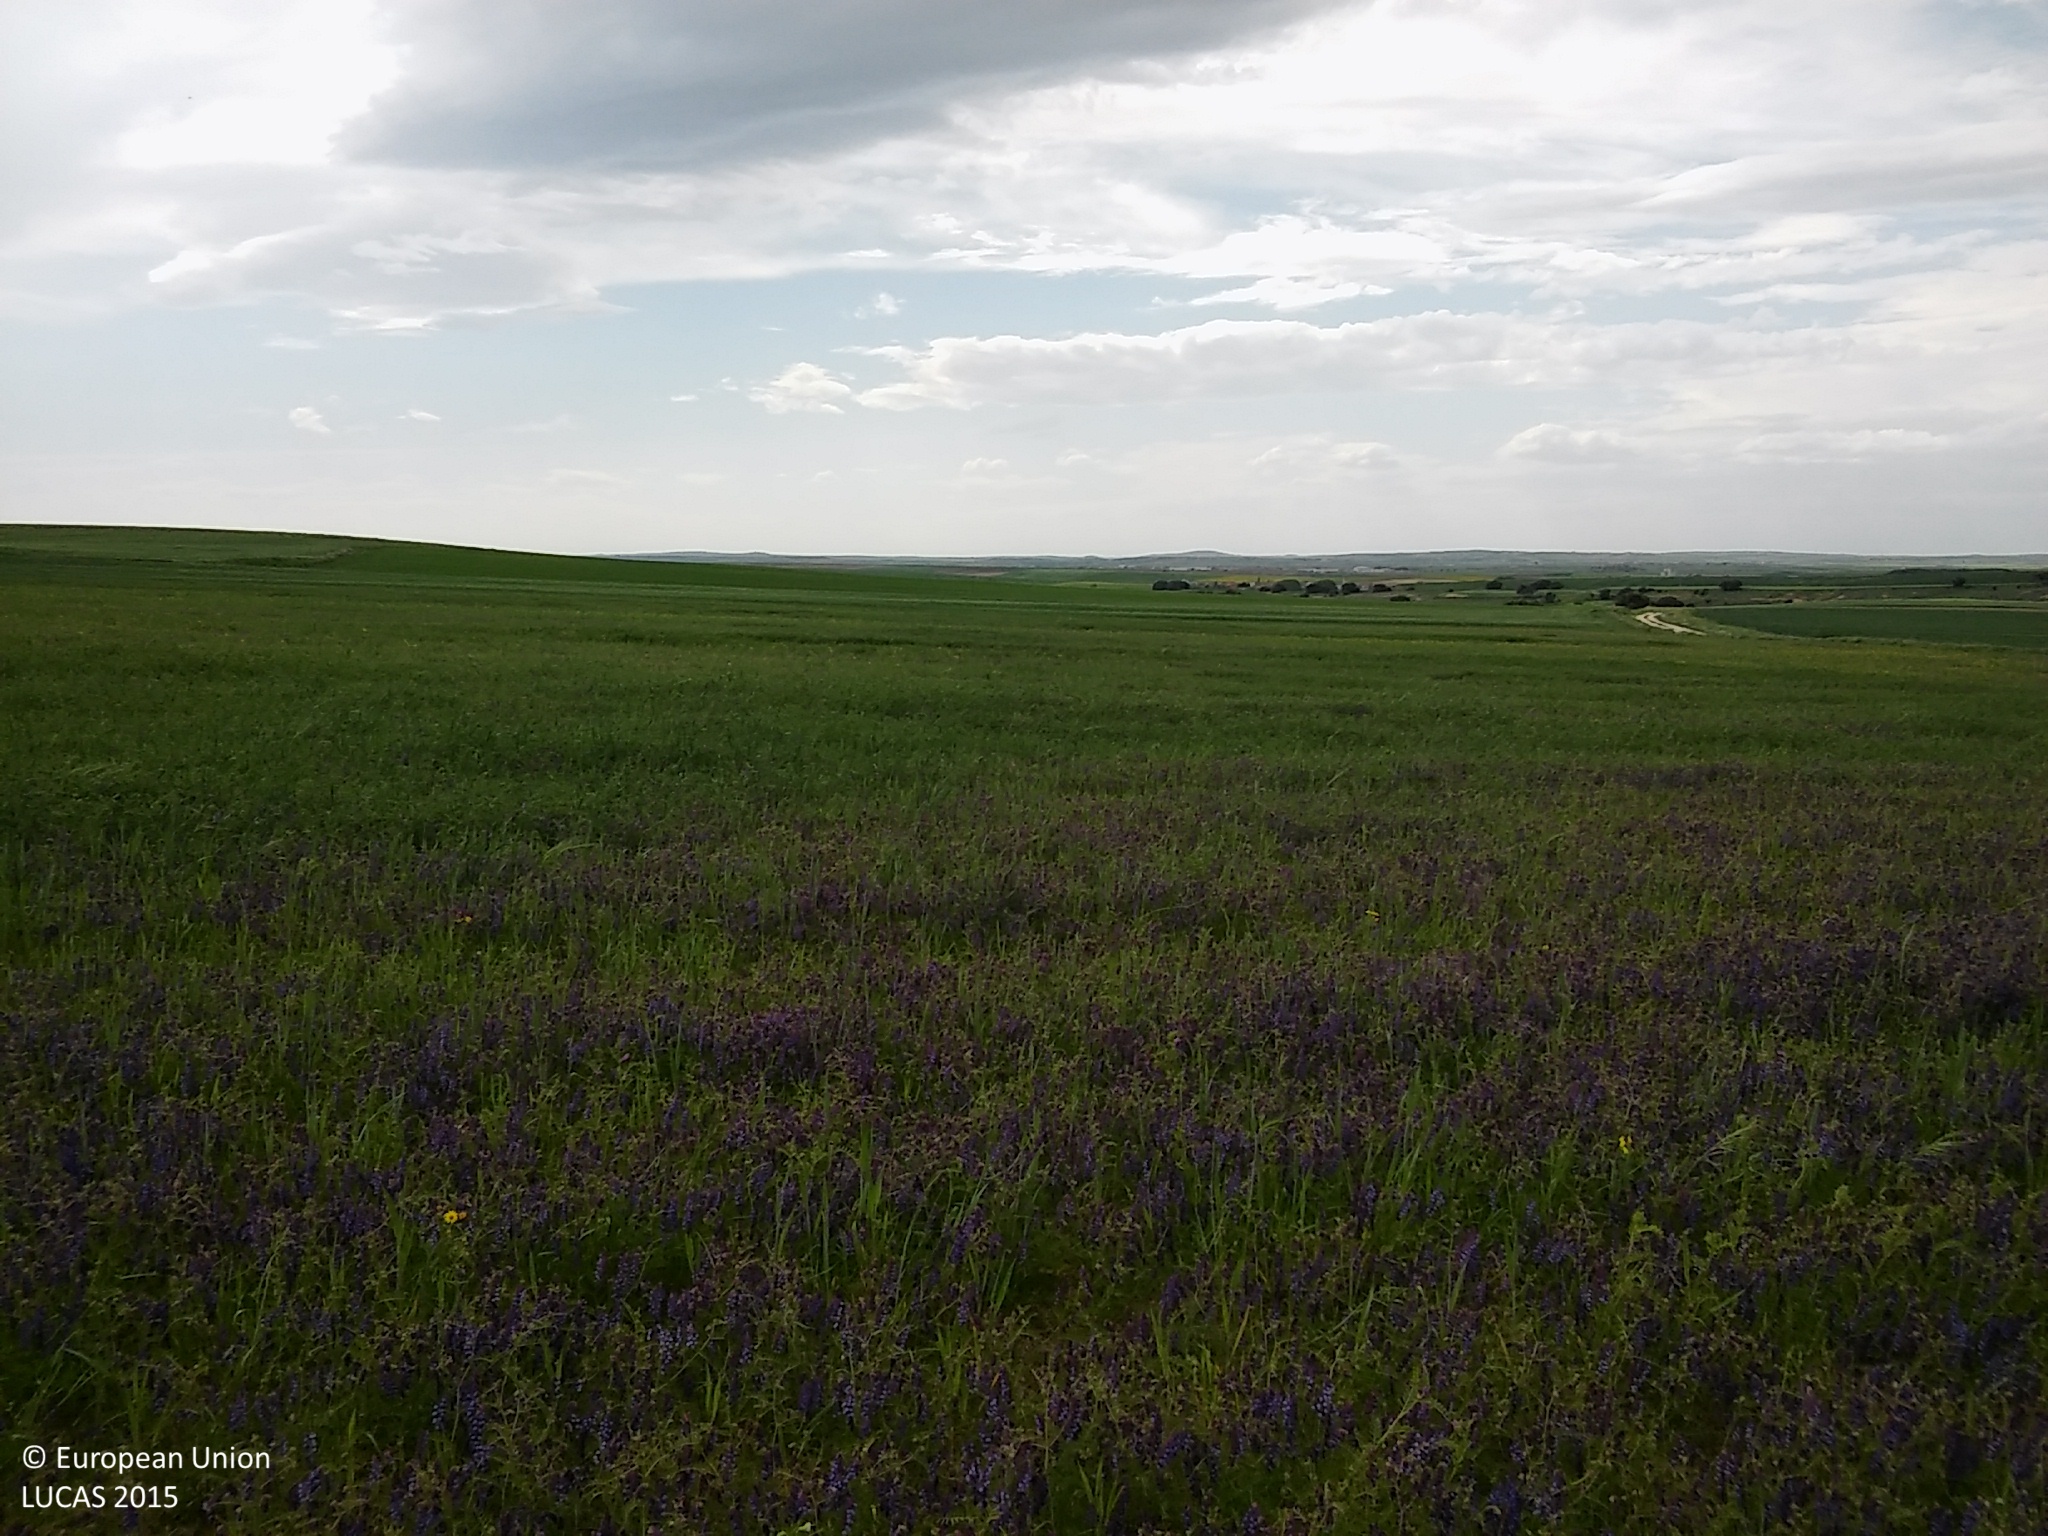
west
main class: Cropland
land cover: Dry pulses
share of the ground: > 75 %
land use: Agriculture (excluding fallow land and kitchen gardens)
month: May
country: ES
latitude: 41.0606
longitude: -4.0805
